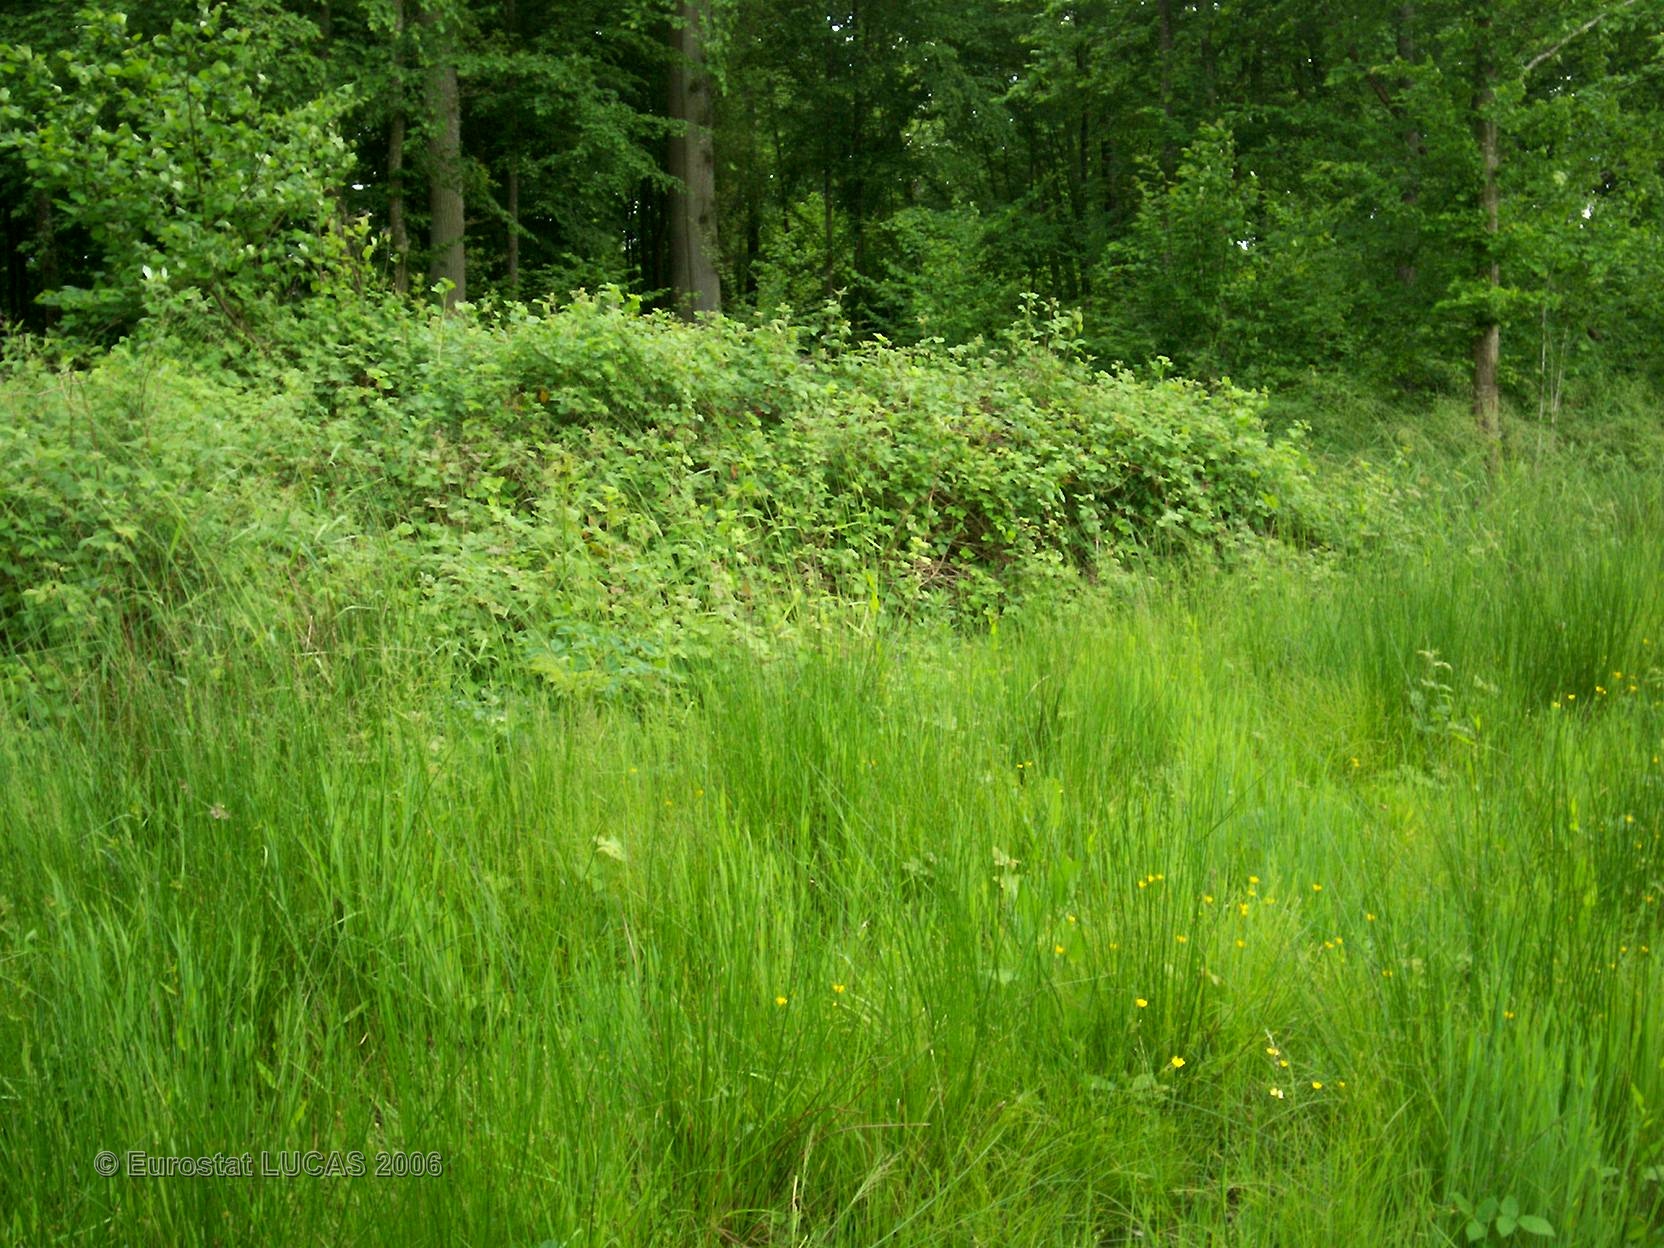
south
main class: Grassland
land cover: Grassland without tree/shrub cover
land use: Agriculture (excluding fallow land and kitchen gardens)
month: May
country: FR
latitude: 48.3650
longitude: 4.6662
